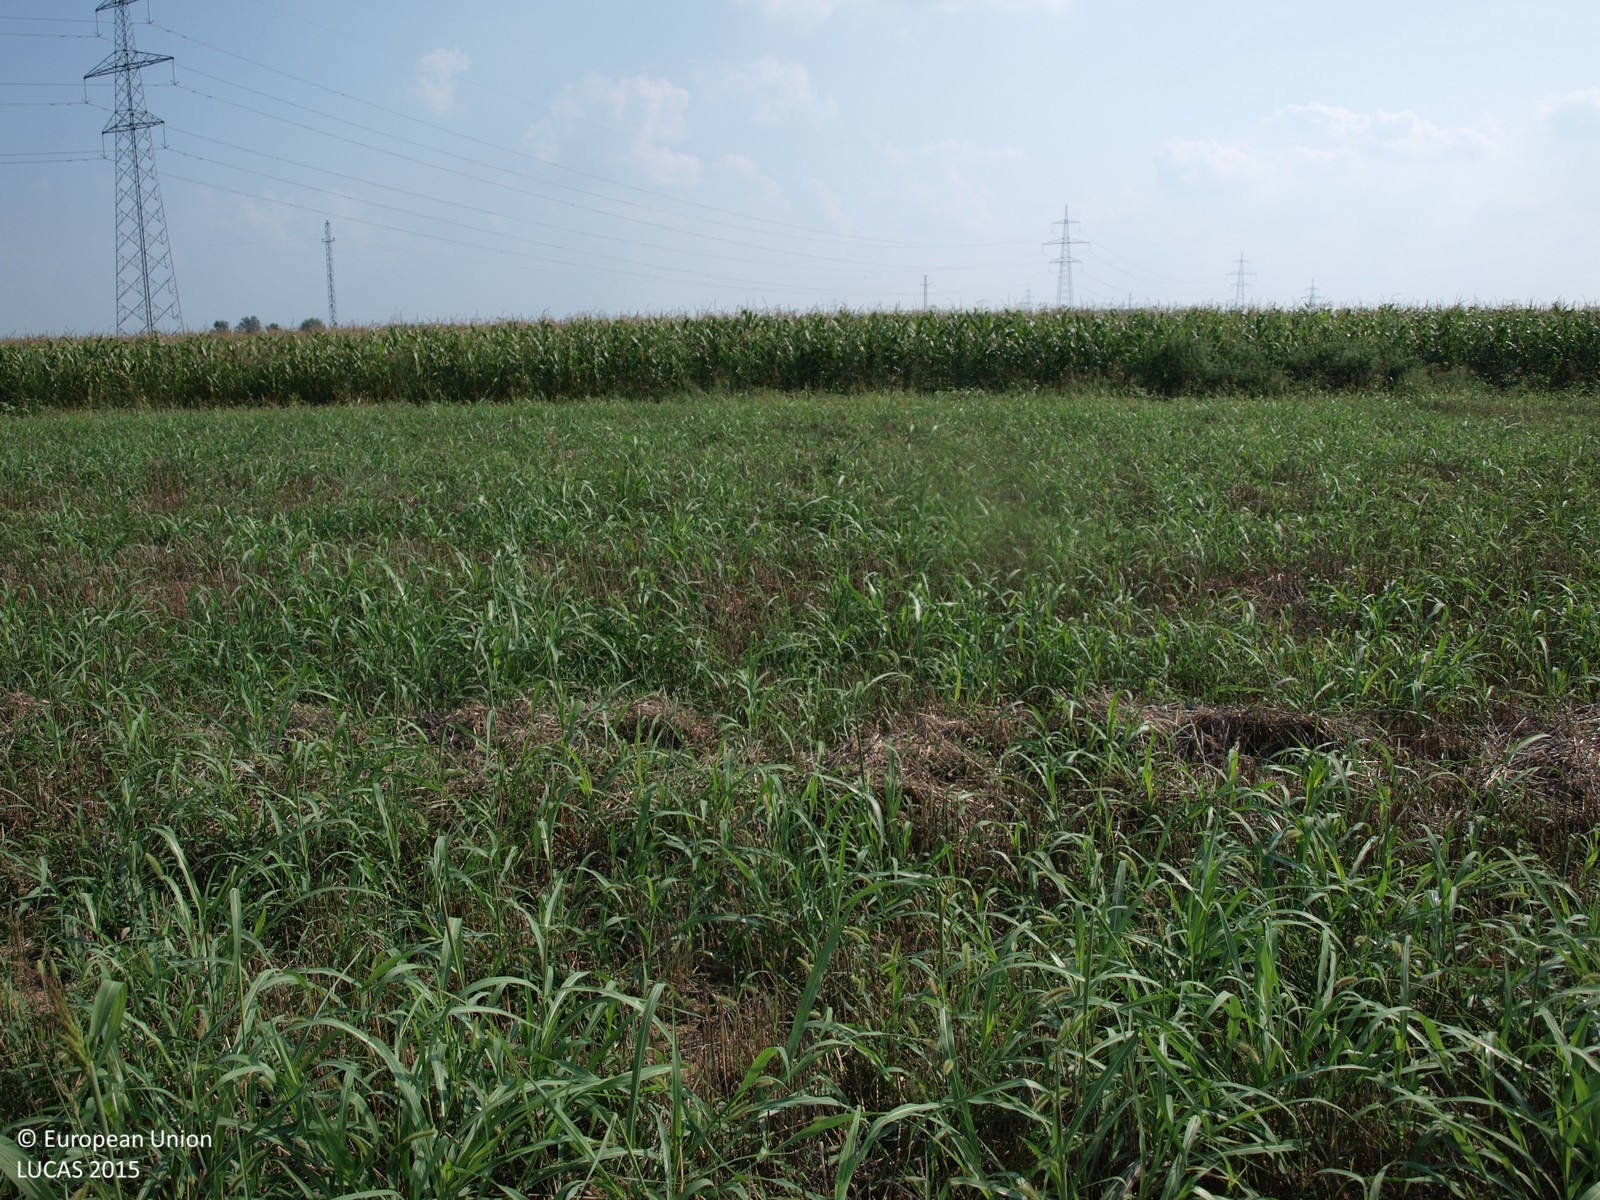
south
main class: Cropland
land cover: Common wheat
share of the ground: > 75 %
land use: Agriculture (excluding fallow land and kitchen gardens)
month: August
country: HR
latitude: 45.7359
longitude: 16.2312
